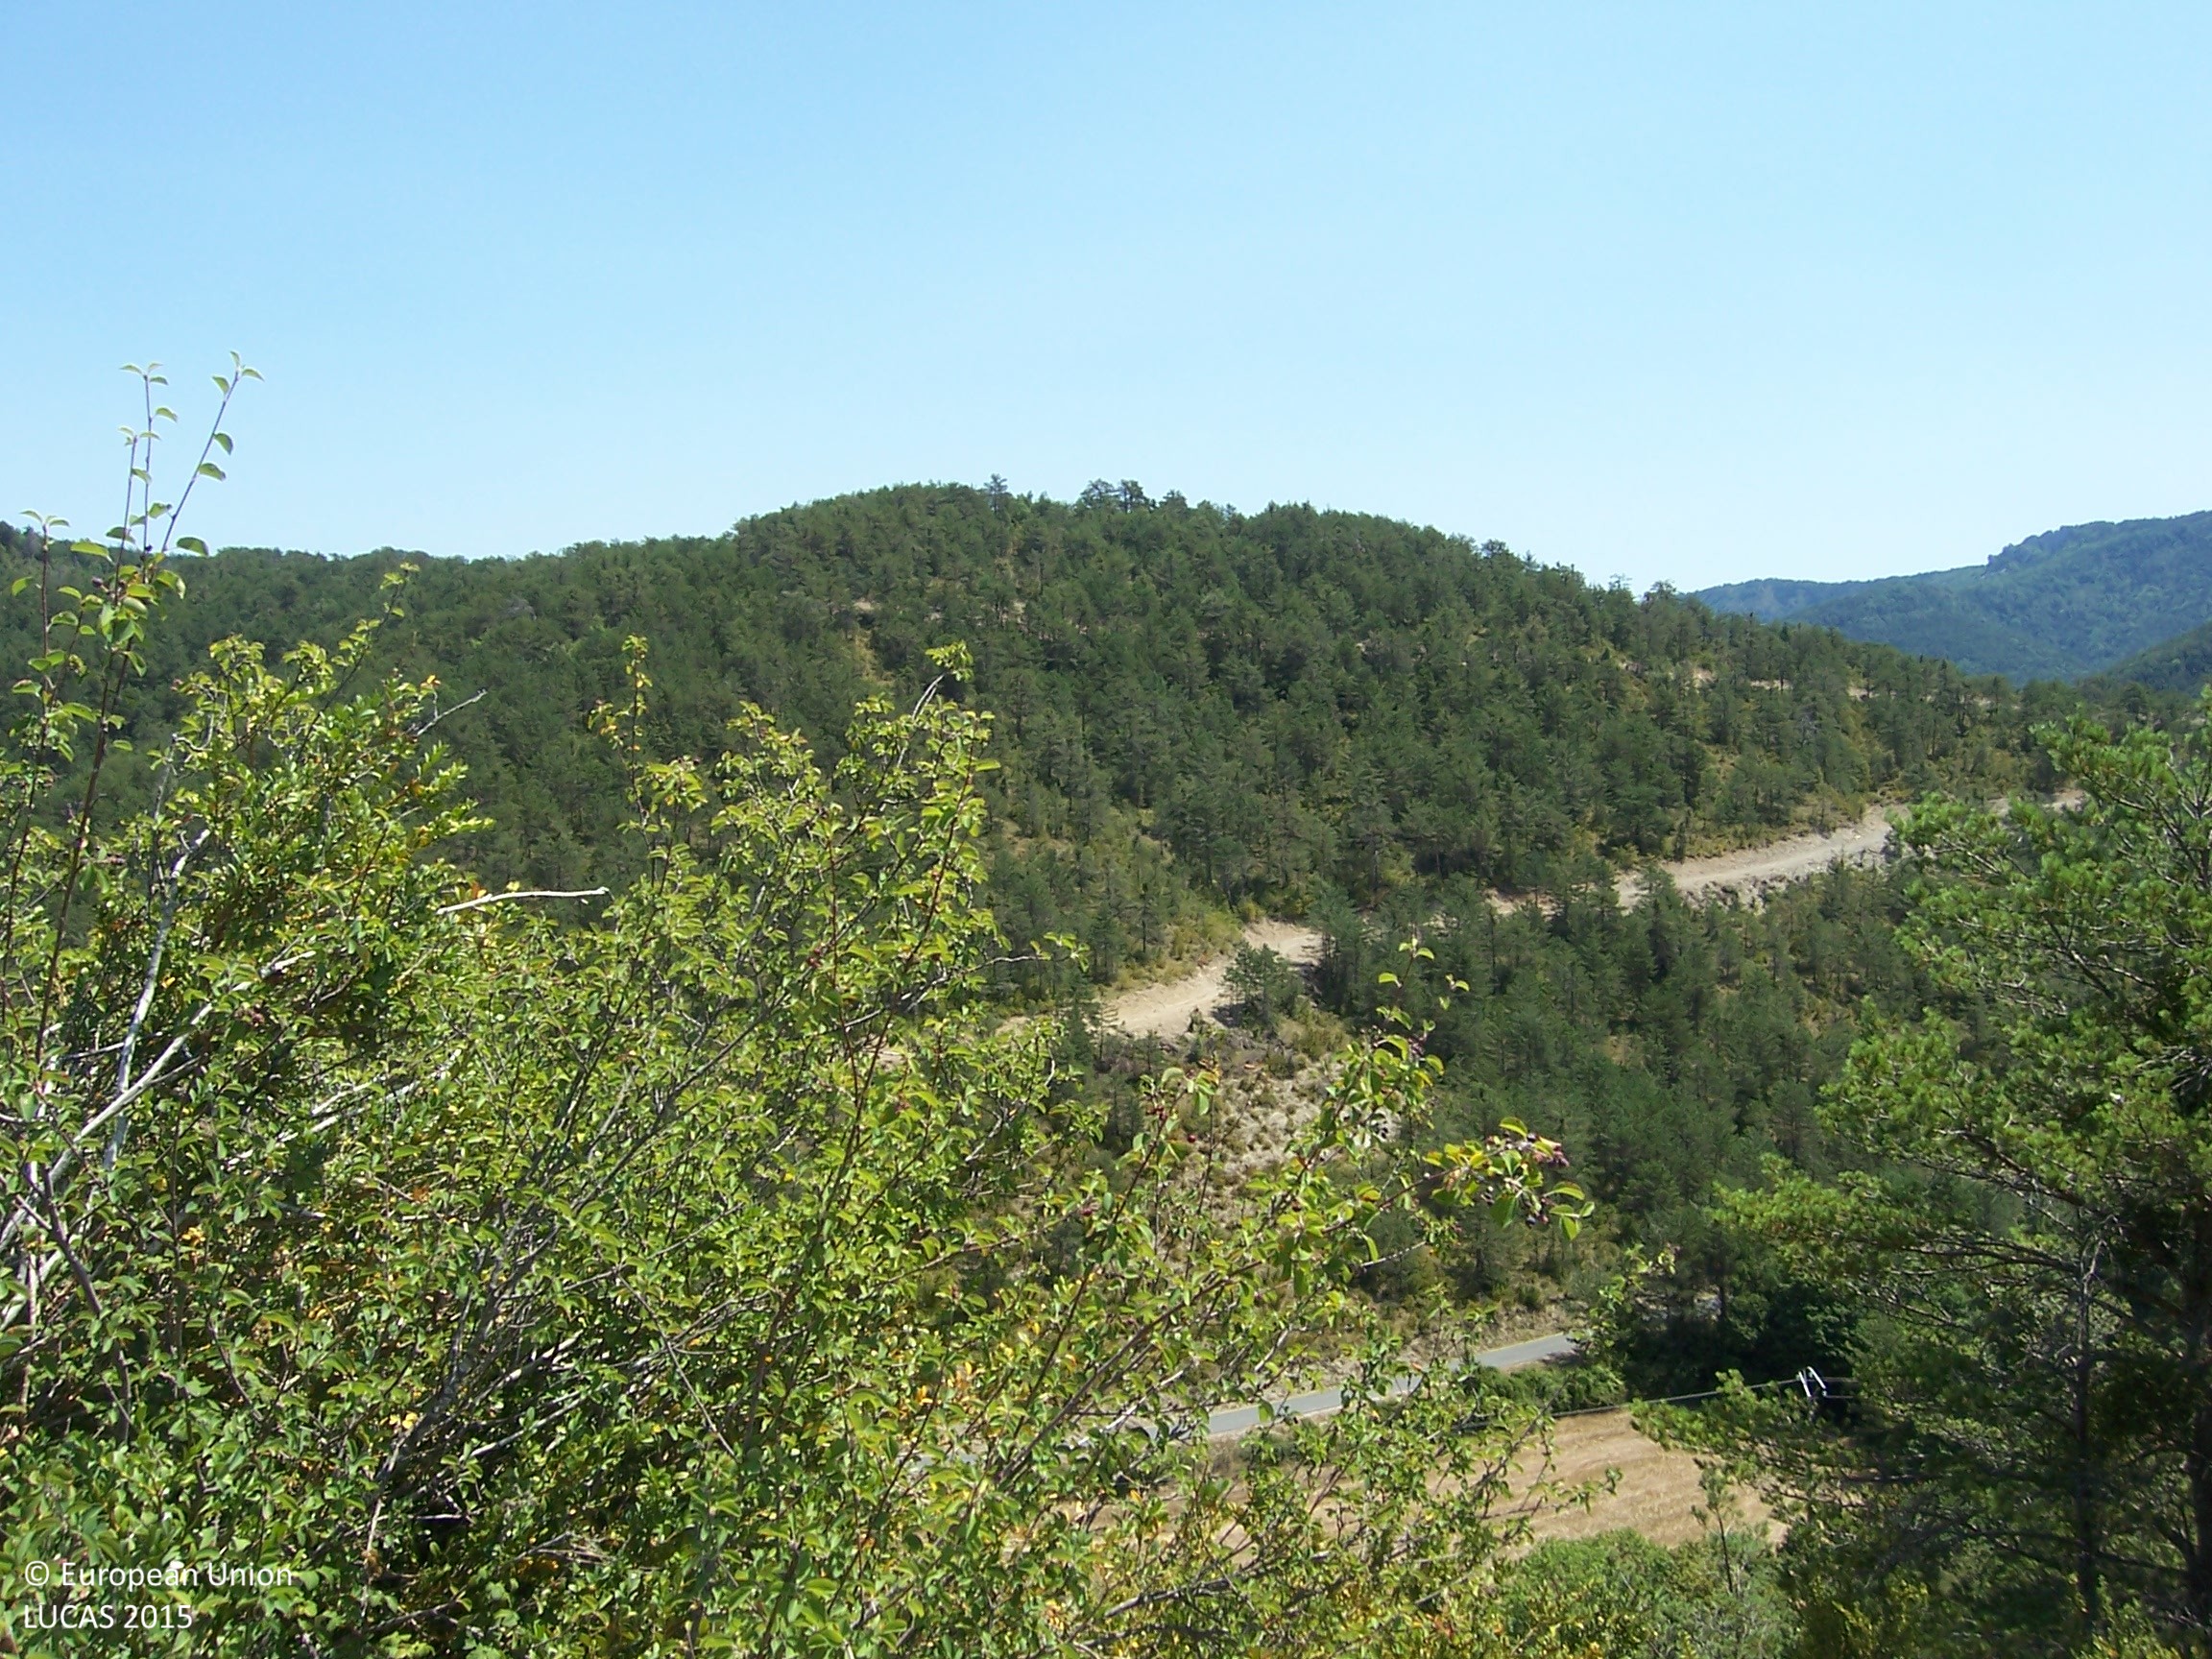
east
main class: Woodland
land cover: Pine dominated coniferous woodland
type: coniferous forest of the mediterranean region
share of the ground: > 75 %
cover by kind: coniferous forest trees 100 %
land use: Forestry
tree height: > 5 m
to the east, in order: Pine dominated coniferous woodland; Tracks; Grassland without tree/shrub cover; Pine dominated coniferous woodland
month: July
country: ES
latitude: 42.8263
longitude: -1.2524
